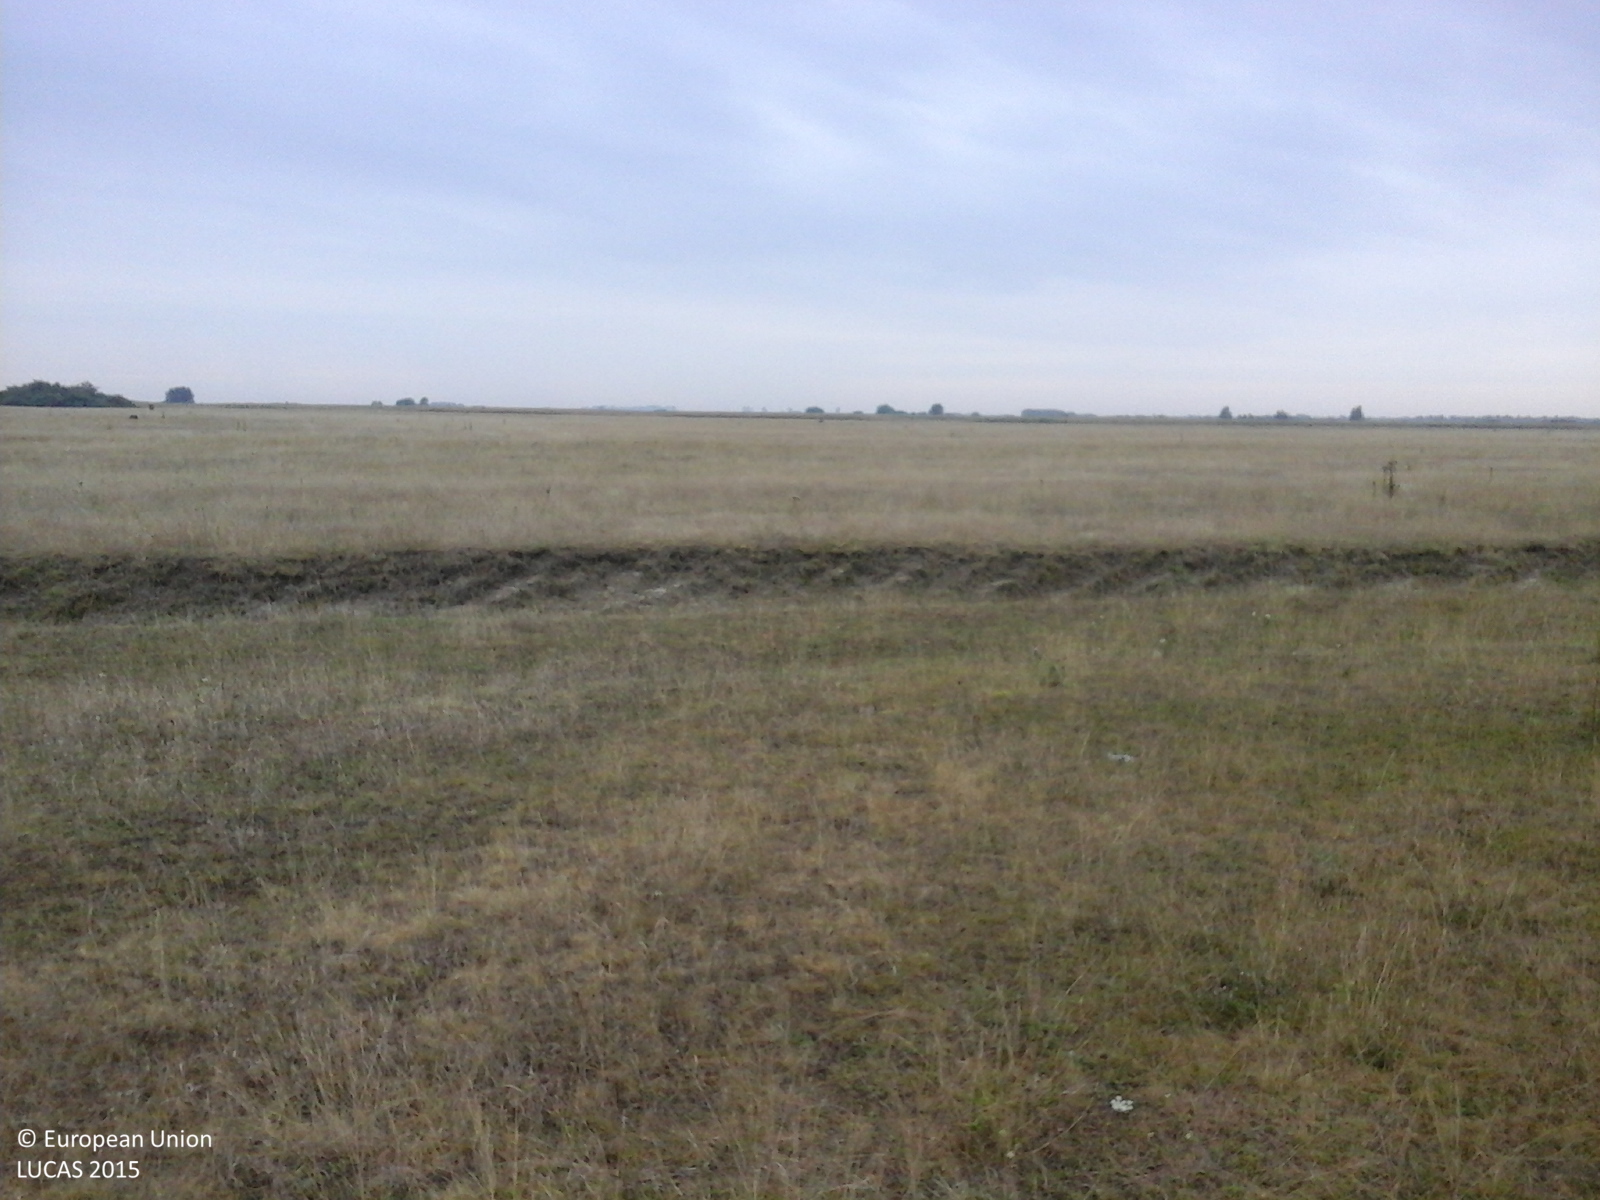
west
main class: Grassland
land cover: Grassland without tree/shrub cover
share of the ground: > 75 %
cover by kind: herbaceous plants 100 %
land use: Agriculture (excluding fallow land and kitchen gardens)
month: August
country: RO
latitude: 45.6852
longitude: 21.0577
